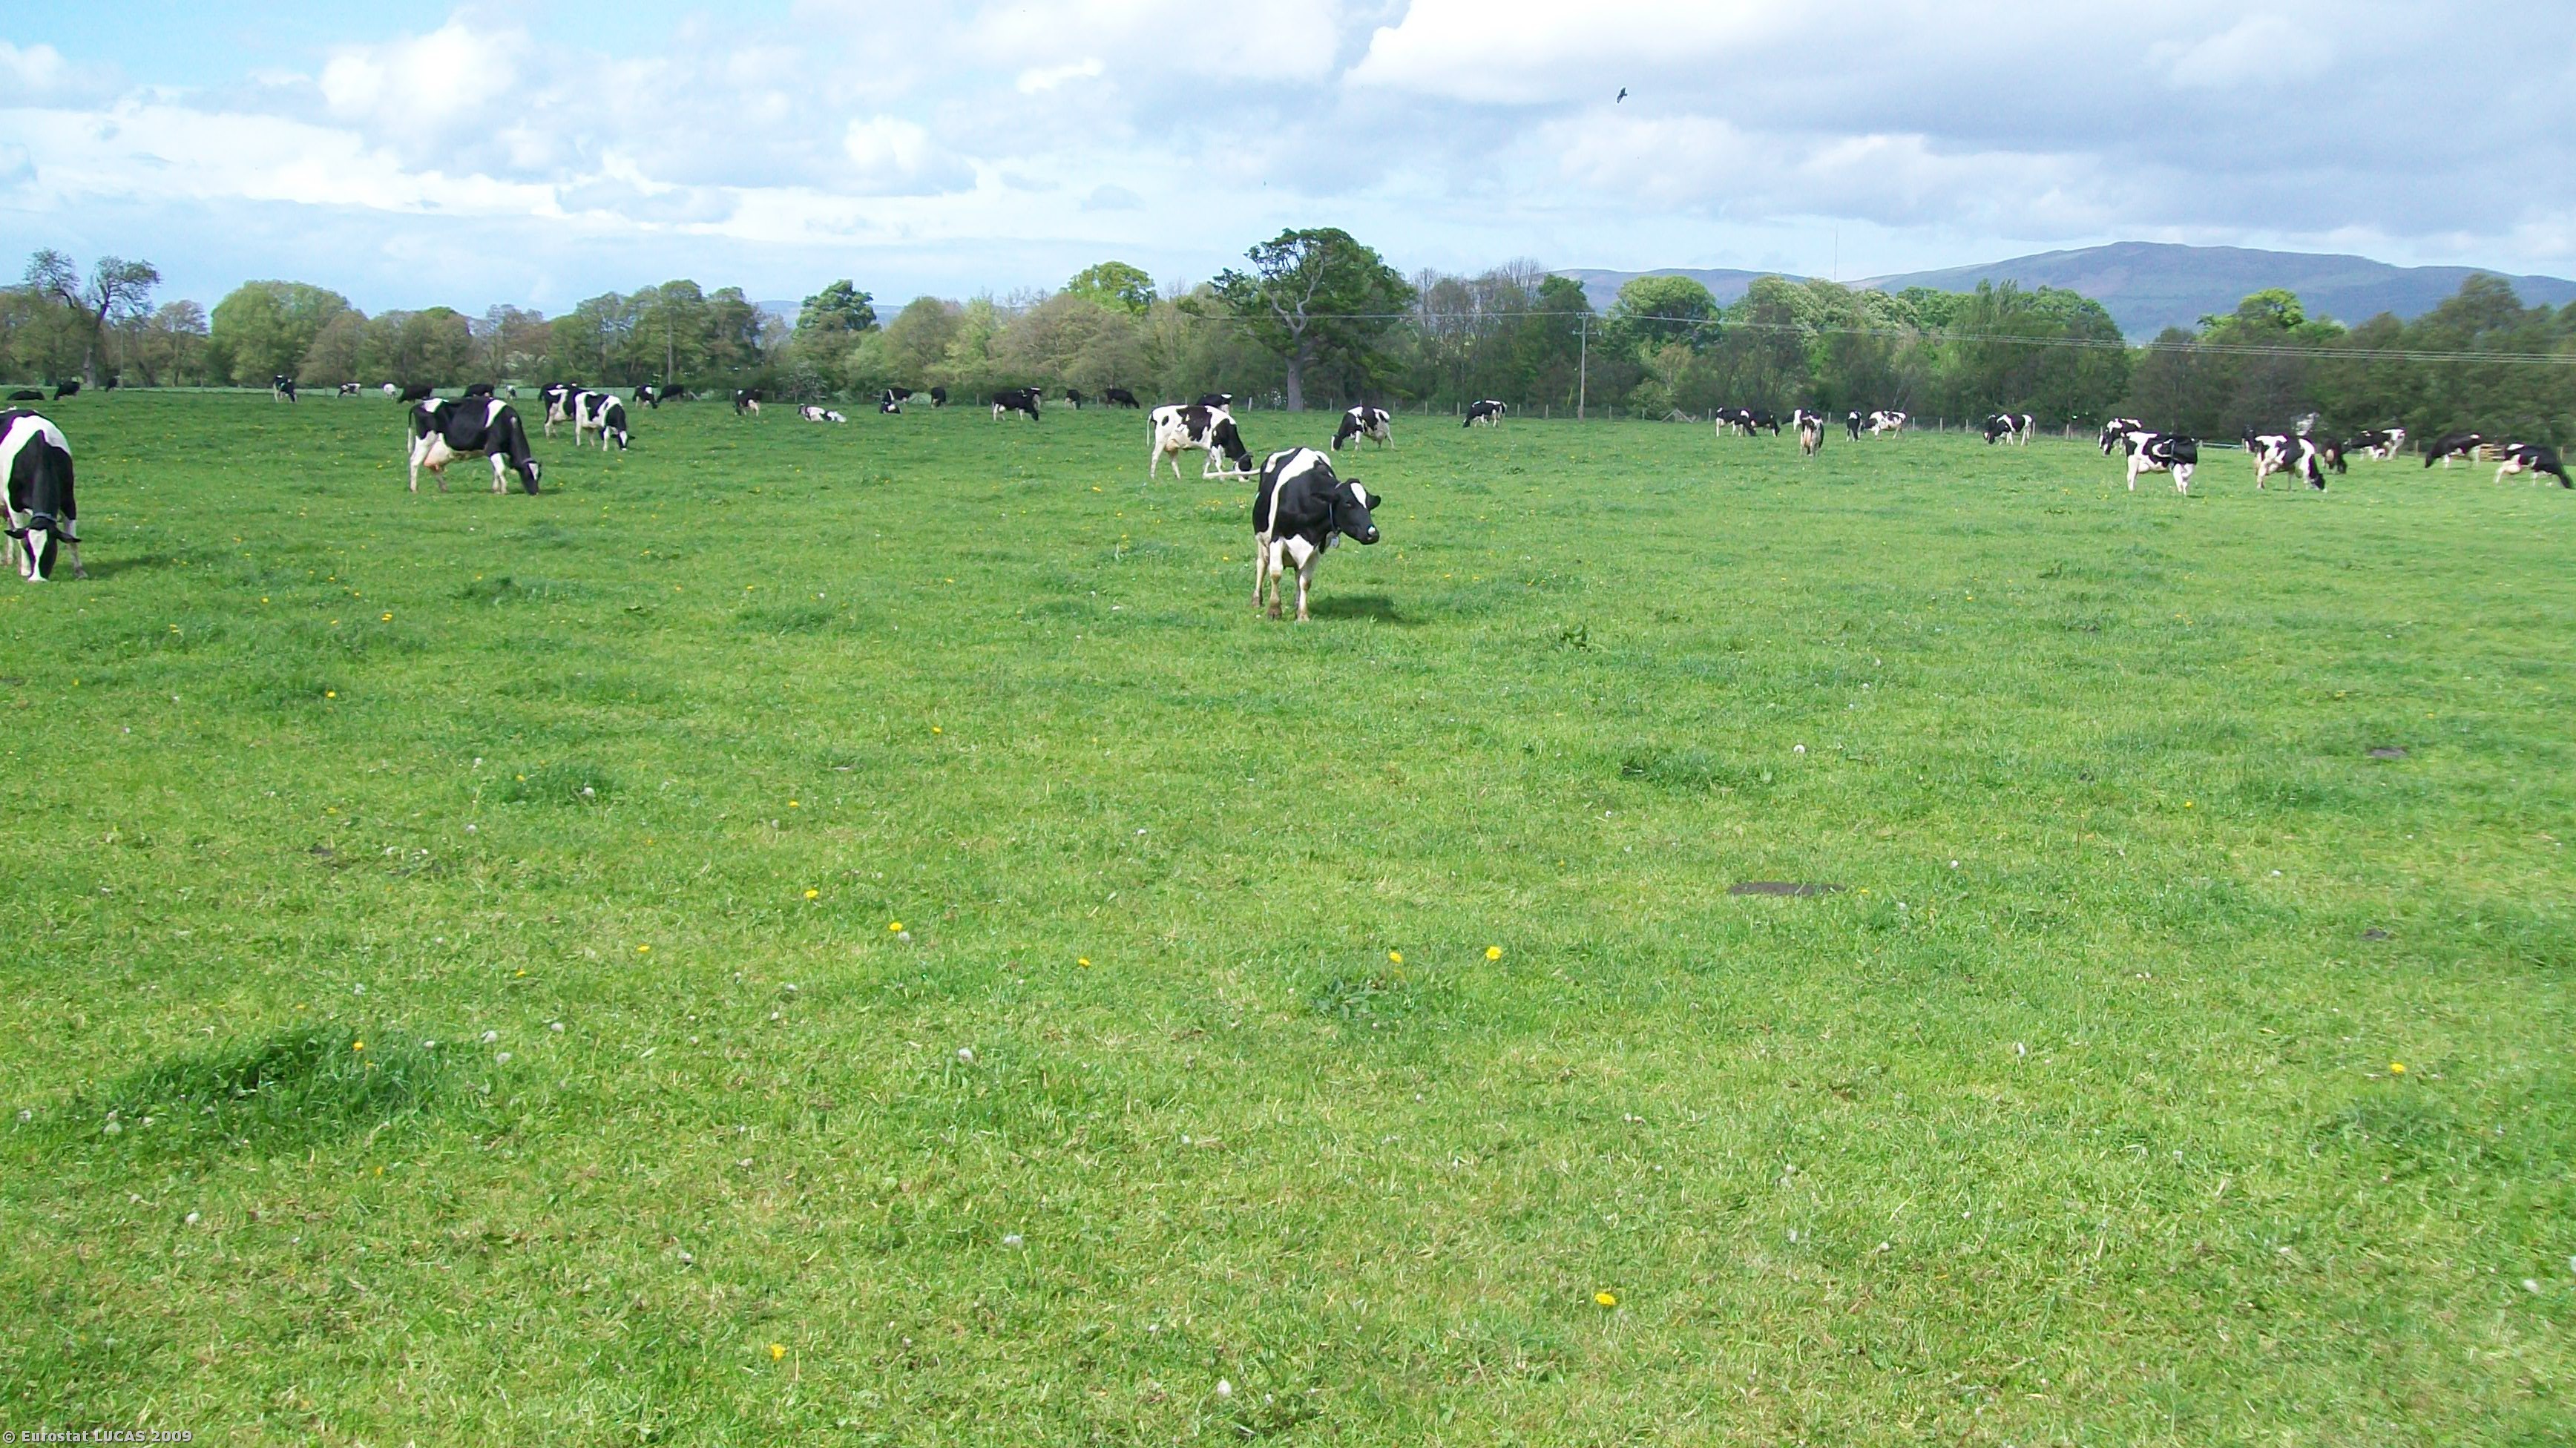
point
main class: Grassland
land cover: Grassland without tree/shrub cover
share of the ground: > 75 %
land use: Agriculture (excluding fallow land and kitchen gardens)
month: May
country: GB
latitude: 53.1338
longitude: -3.3387
